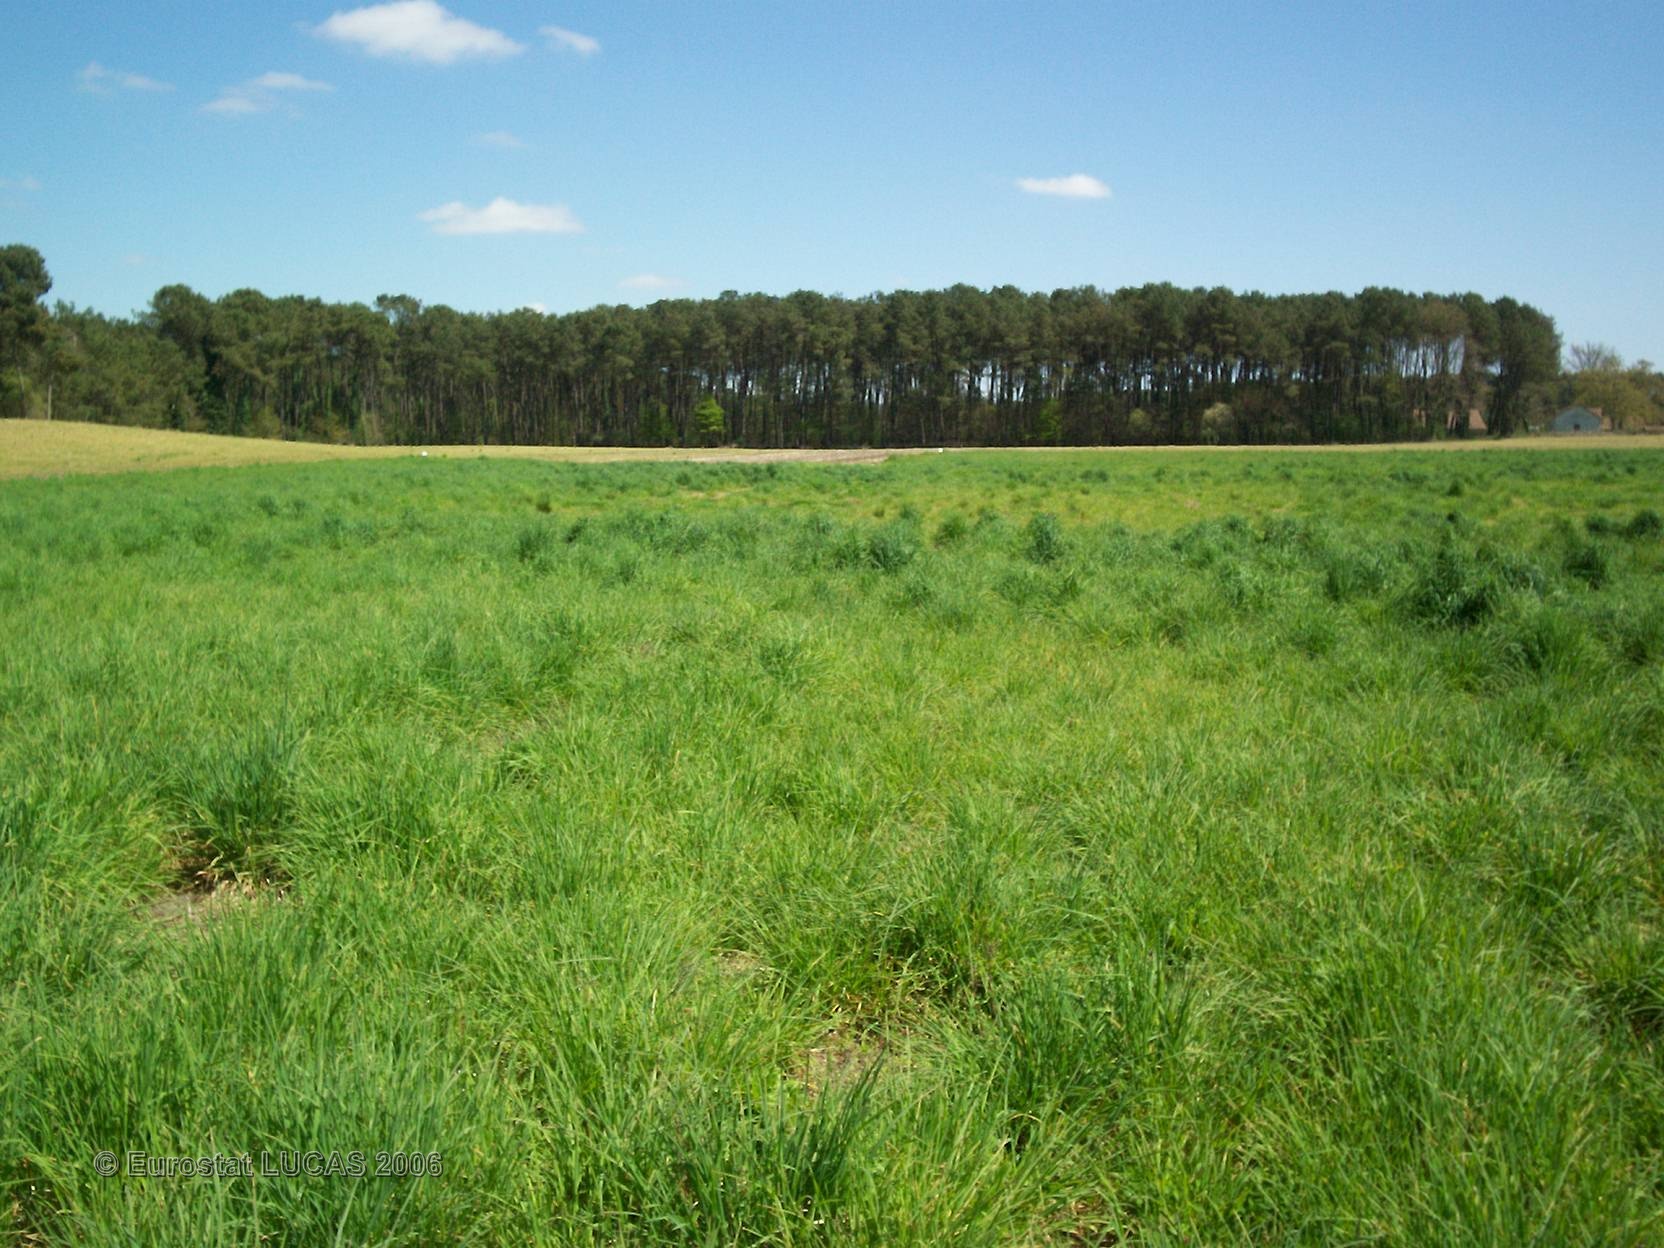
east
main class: Grassland
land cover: Grassland without tree/shrub cover
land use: Agriculture (excluding fallow land and kitchen gardens)
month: April
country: FR
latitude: 43.8121
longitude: -0.7170
